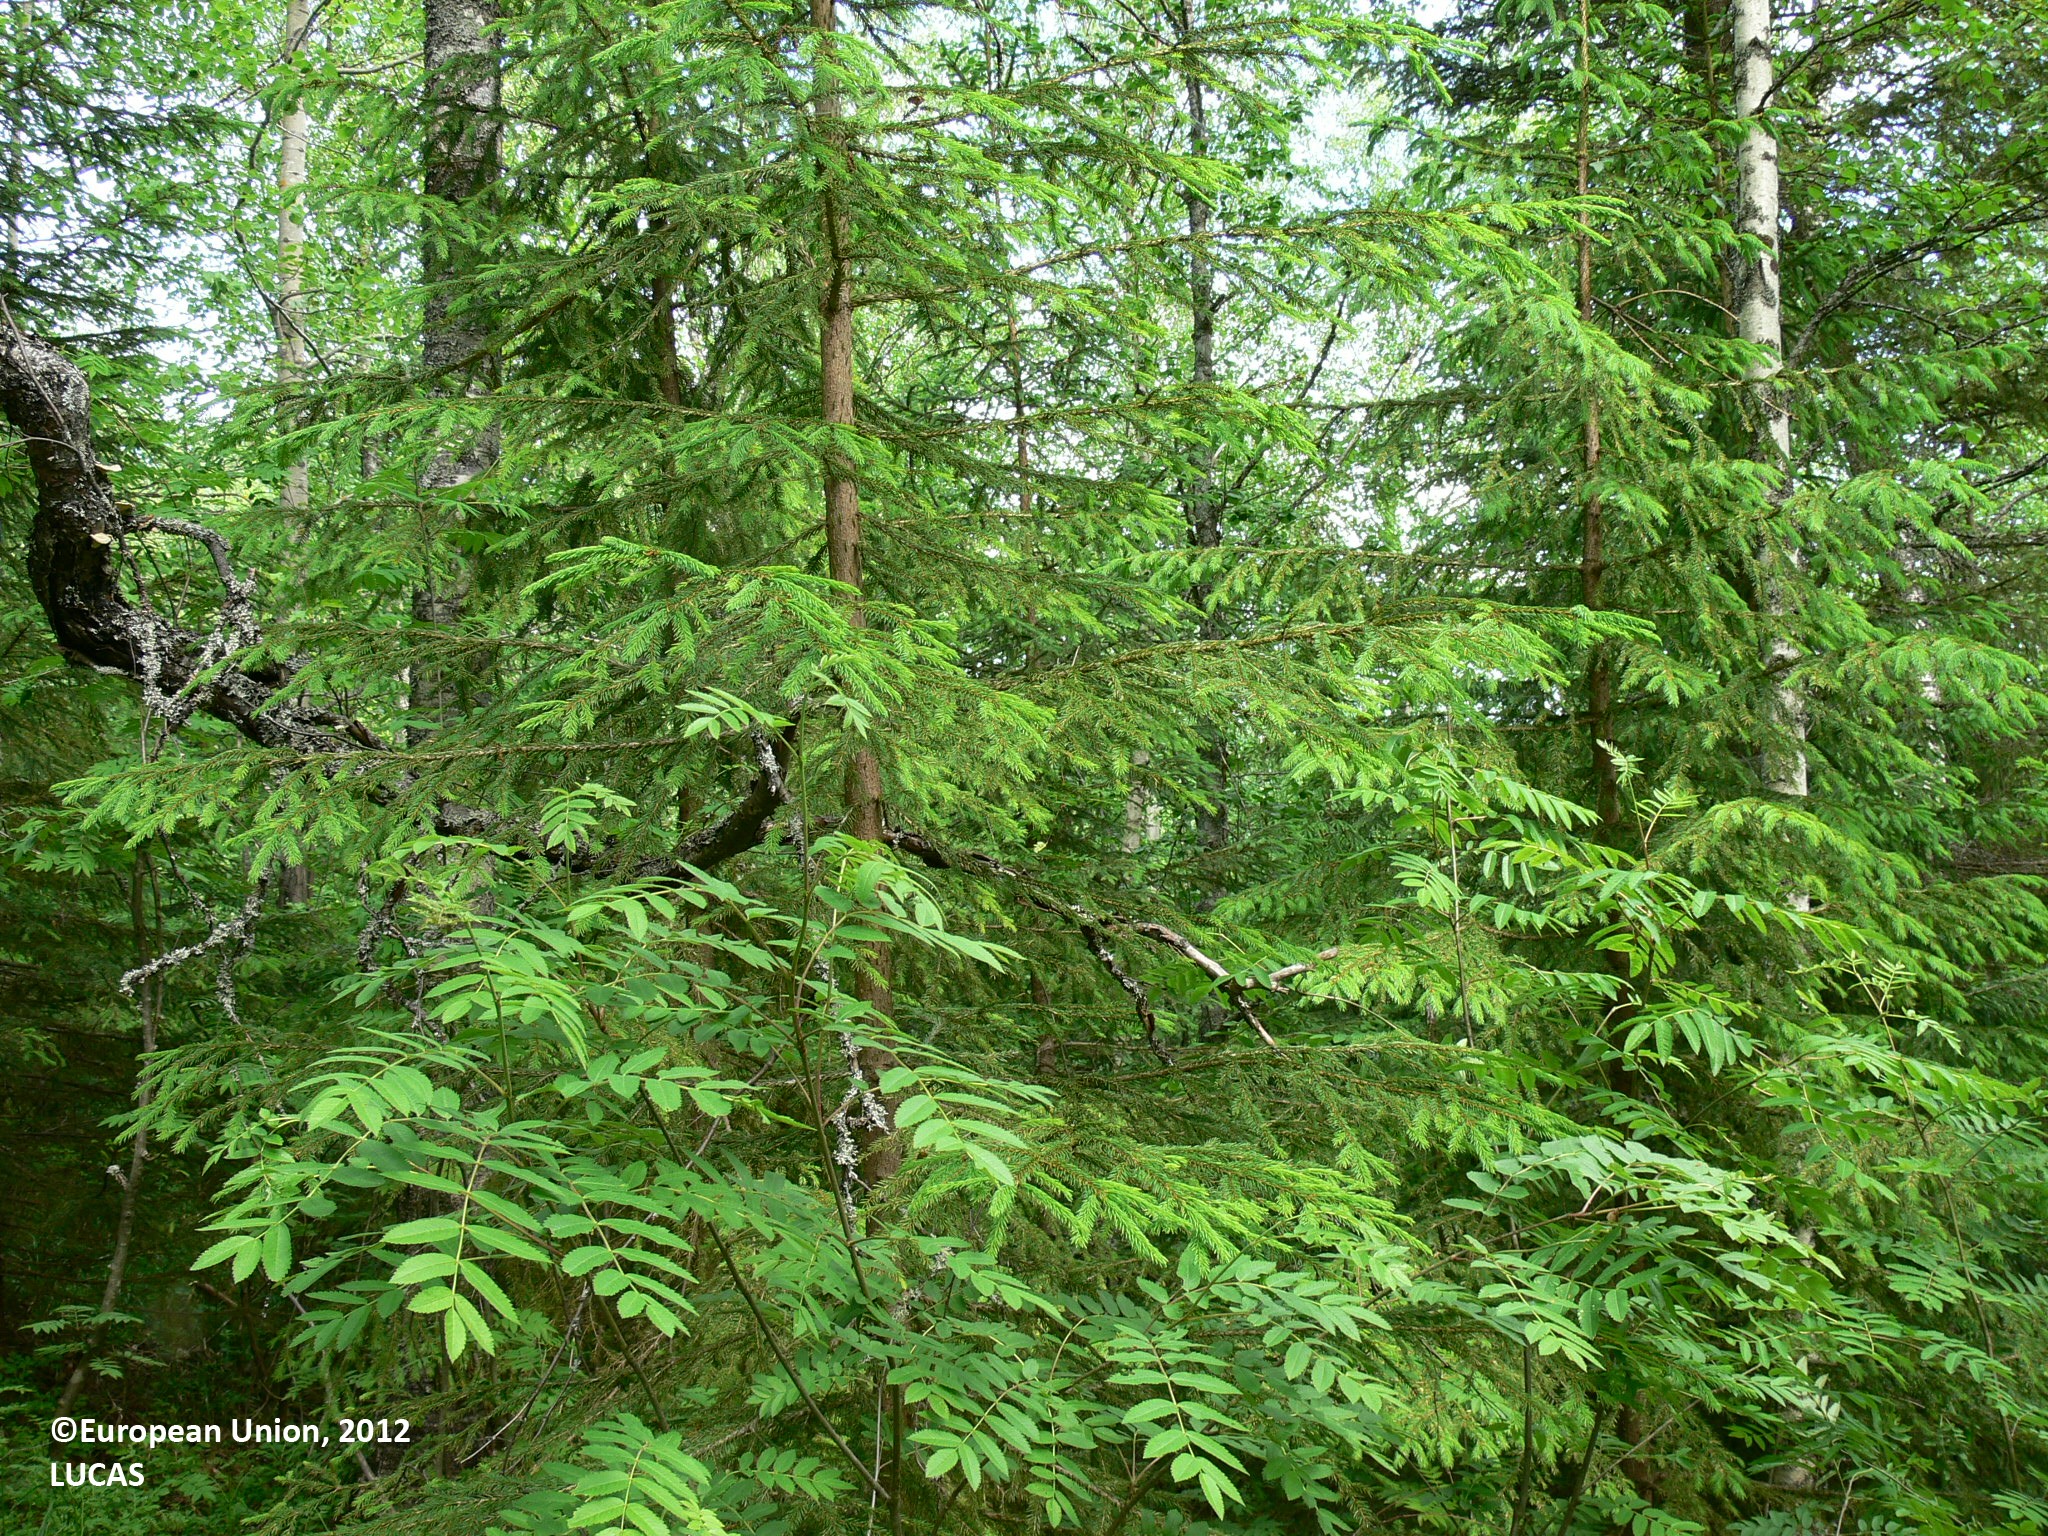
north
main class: Woodland
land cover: Spruce dominated mixed woodland
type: boreal forest
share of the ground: > 75 %
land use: Forestry
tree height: > 5 m
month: June
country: FI
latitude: 62.8229
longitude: 29.9787
